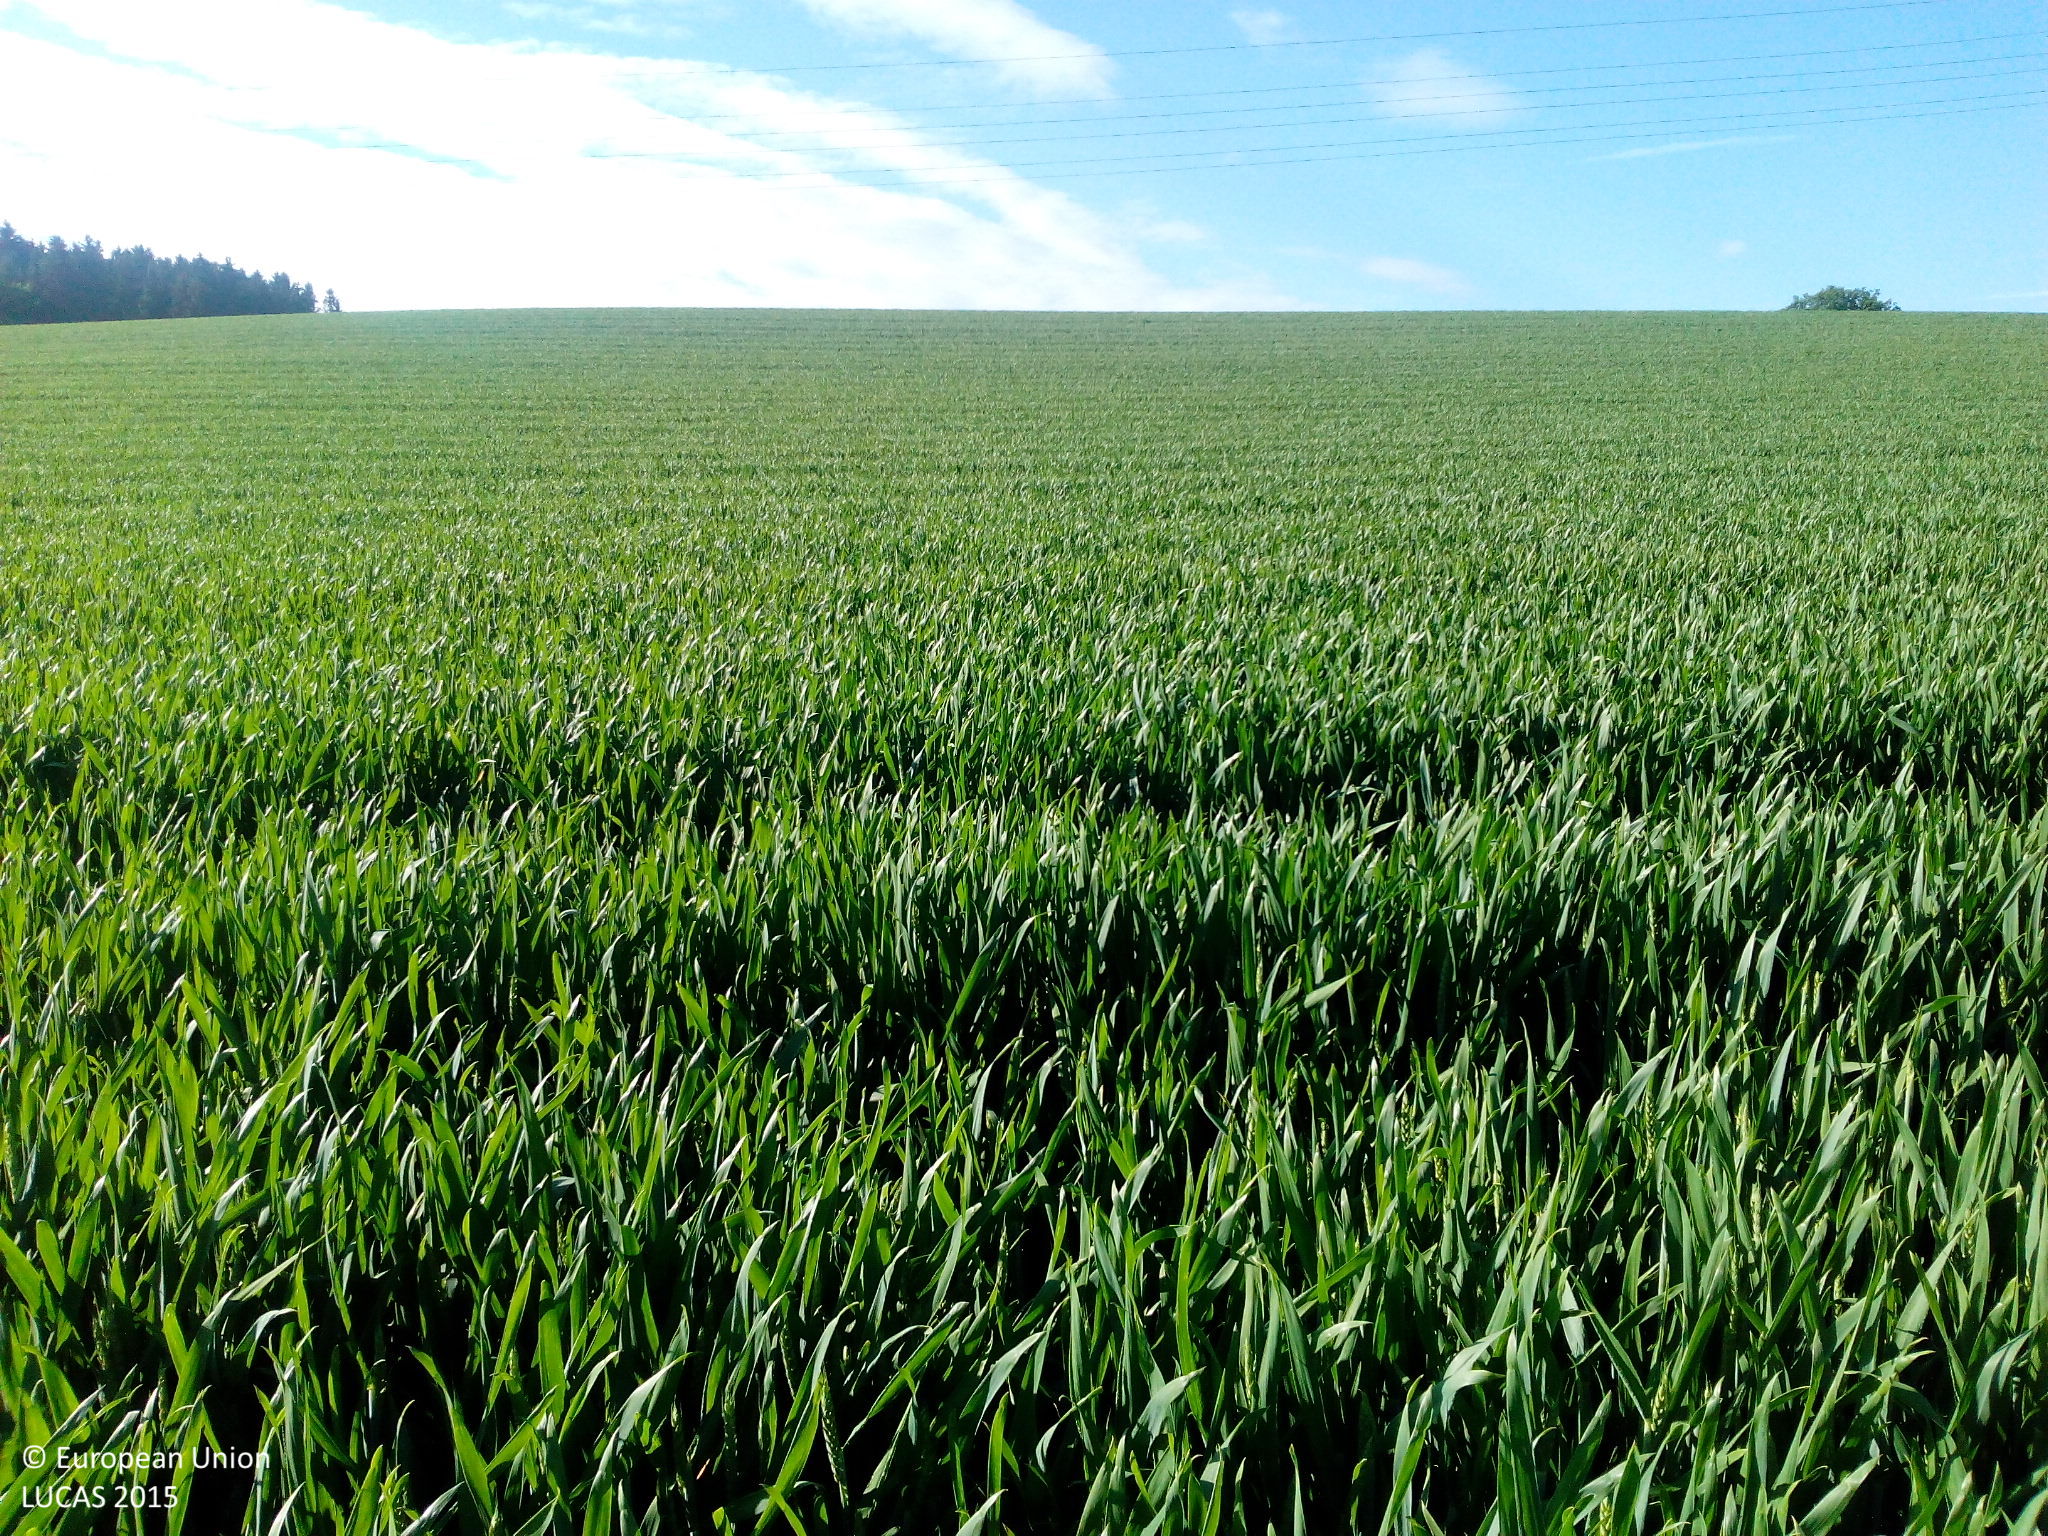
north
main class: Cropland
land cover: Common wheat
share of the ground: > 75 %
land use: Agriculture (excluding fallow land and kitchen gardens)
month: June
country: DE
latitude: 48.7079
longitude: 12.0784
